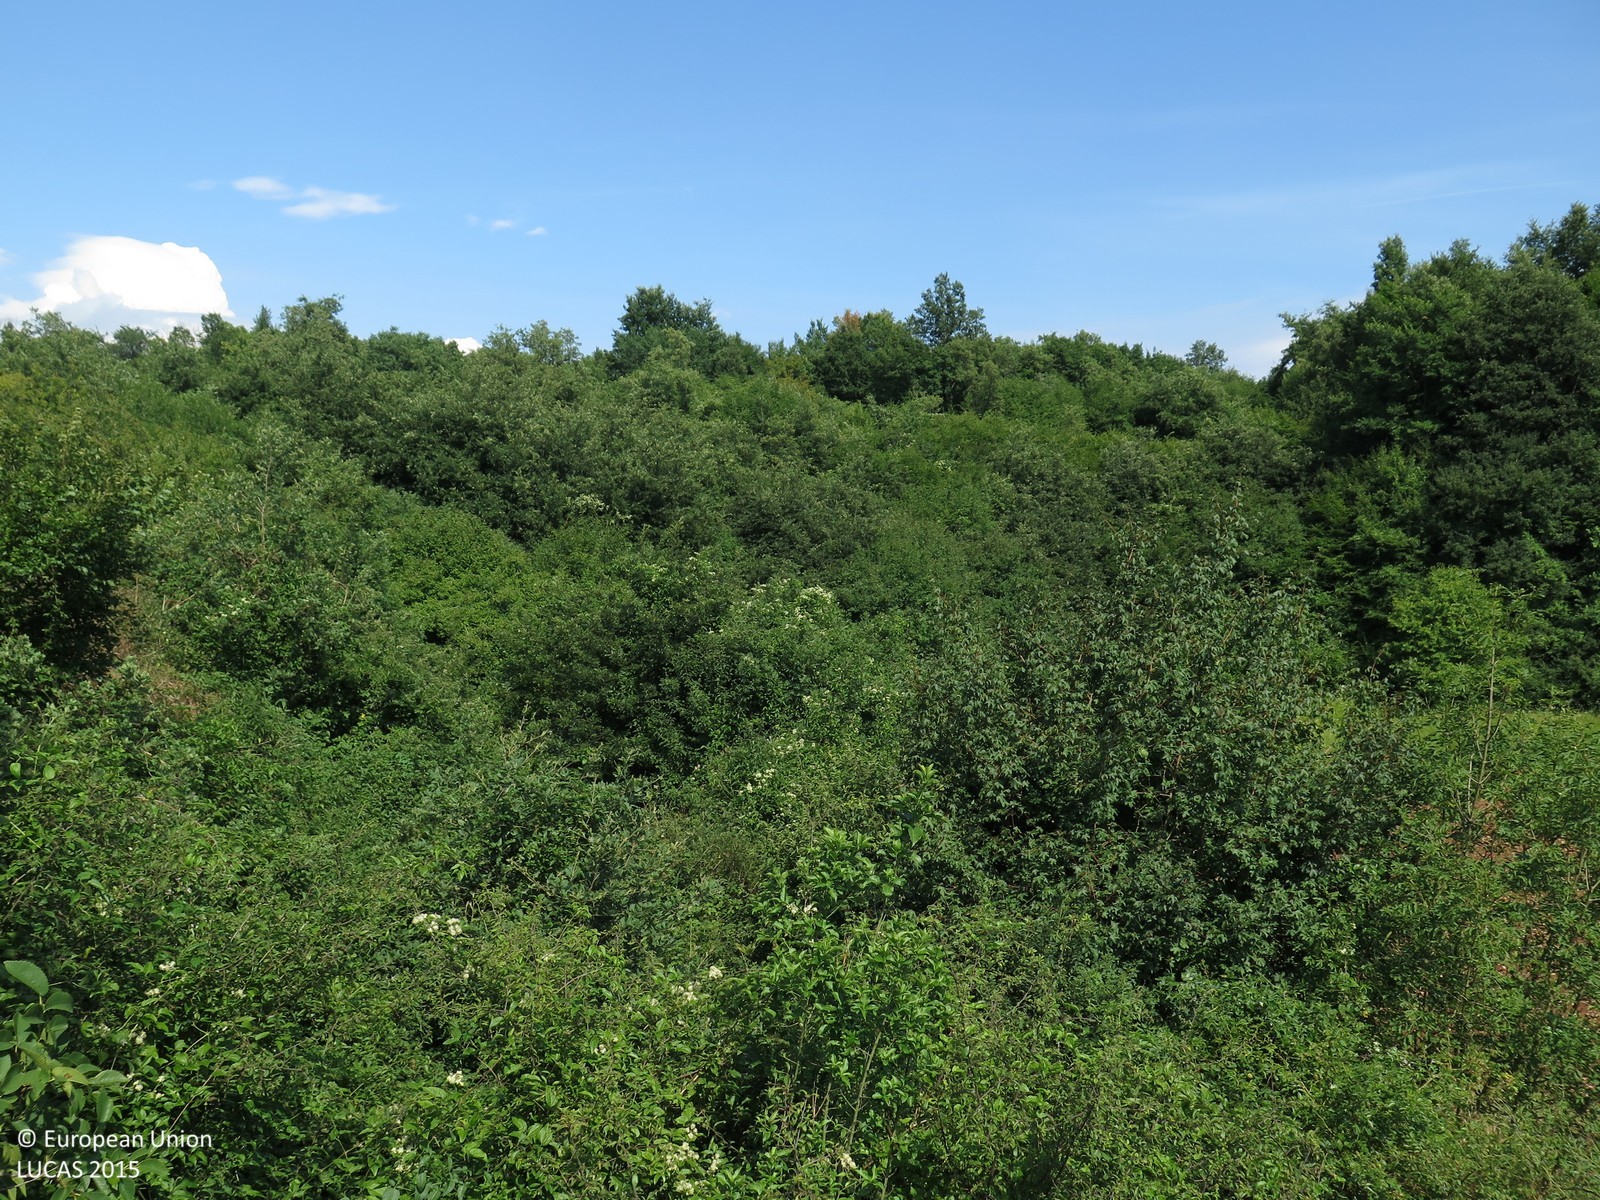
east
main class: Shrubland
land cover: Shrubland with sparse tree cover
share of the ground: > 75 %
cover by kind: shrubs 75 %, herbaceous plants 15 %, broadleaved forest trees 5 %, unconsolidated bare surface 5 %
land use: Semi-natural and natural areas not in use
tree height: > 5 m
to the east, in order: Shrubland with sparse tree cover; Permanent industrial crops; Dry stone walls; Other fruit trees and berries; Broadleaved woodland; Grassland without tree/shrub cover; Temporary grasslands; Grassland without tree/shrub cover; Broadleaved woodland; Dry stone walls; Tracks; Grass margins; Tracks; Abandoned hedges
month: June
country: HR
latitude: 45.1816
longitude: 13.8507
